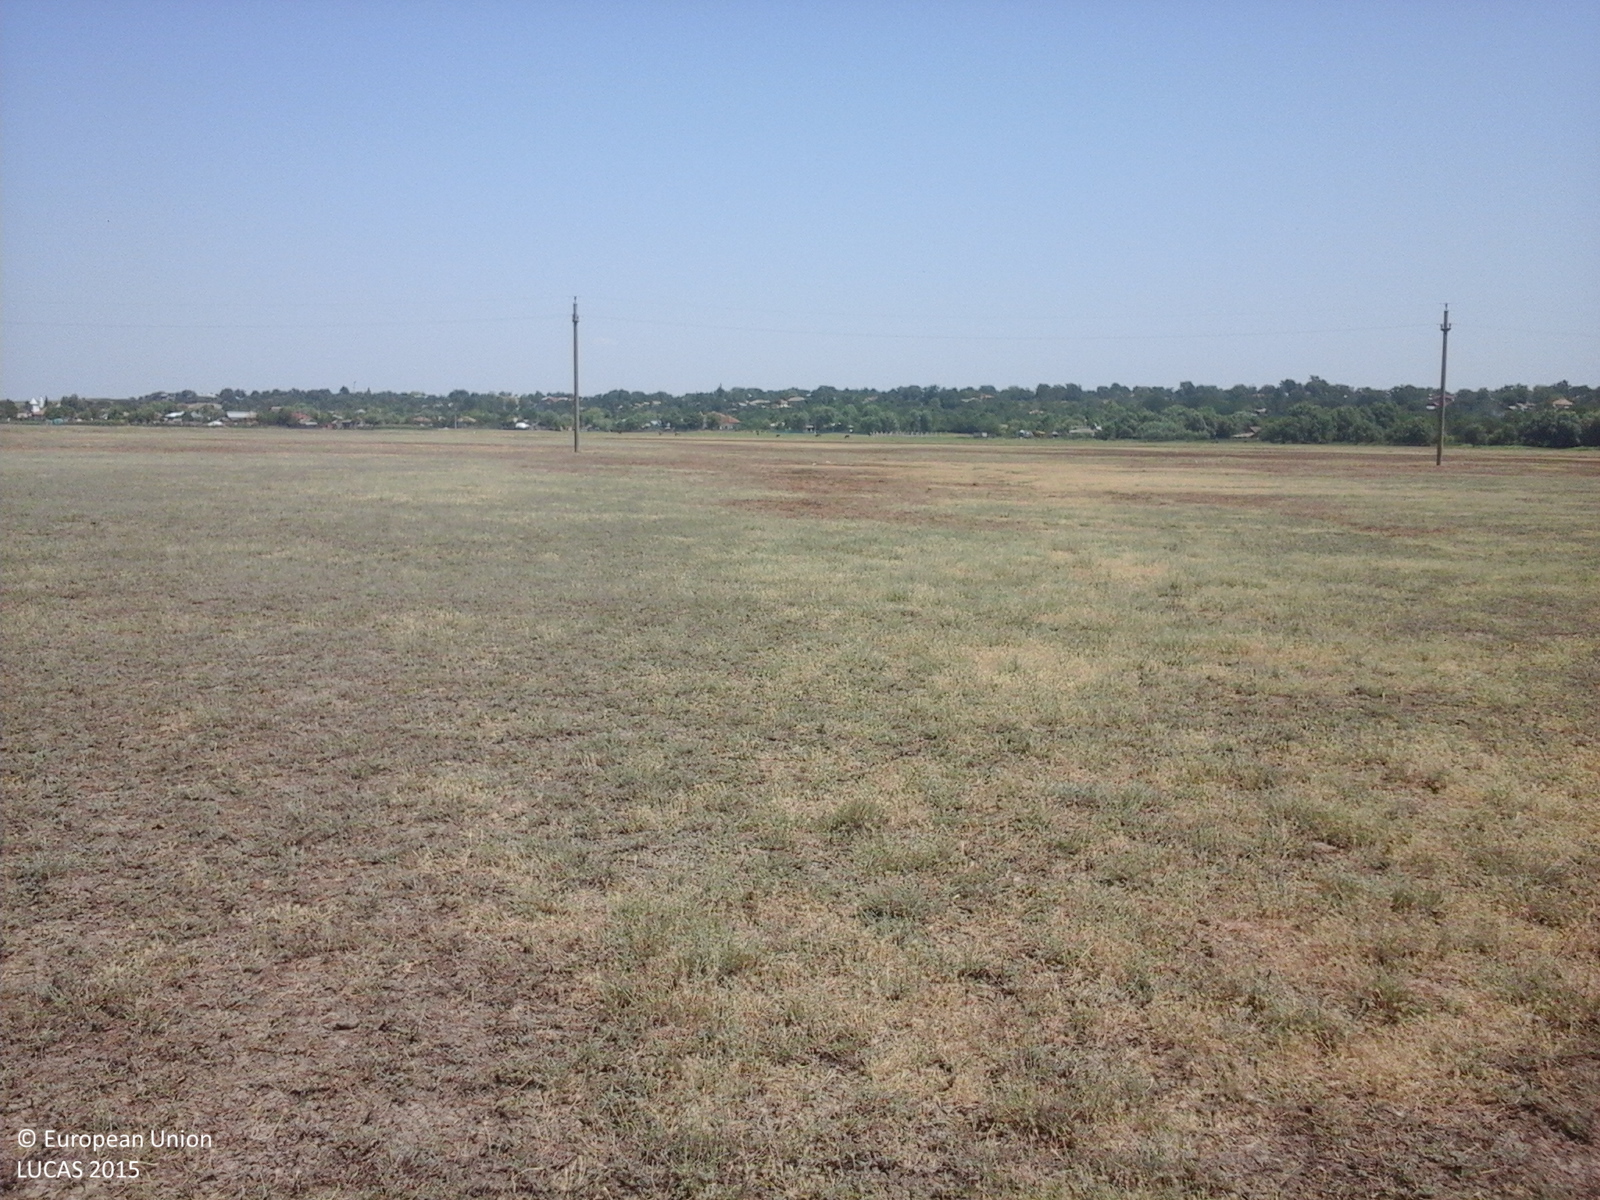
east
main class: Grassland
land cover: Grassland without tree/shrub cover
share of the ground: > 75 %
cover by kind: herbaceous plants 100 %
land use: Agriculture (excluding fallow land and kitchen gardens)
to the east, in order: Grassland without tree/shrub cover; Electric lines; Grassland without tree/shrub cover; Ditches and canals; Grassland without tree/shrub cover
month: July
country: RO
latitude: 44.5663
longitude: 27.5850
